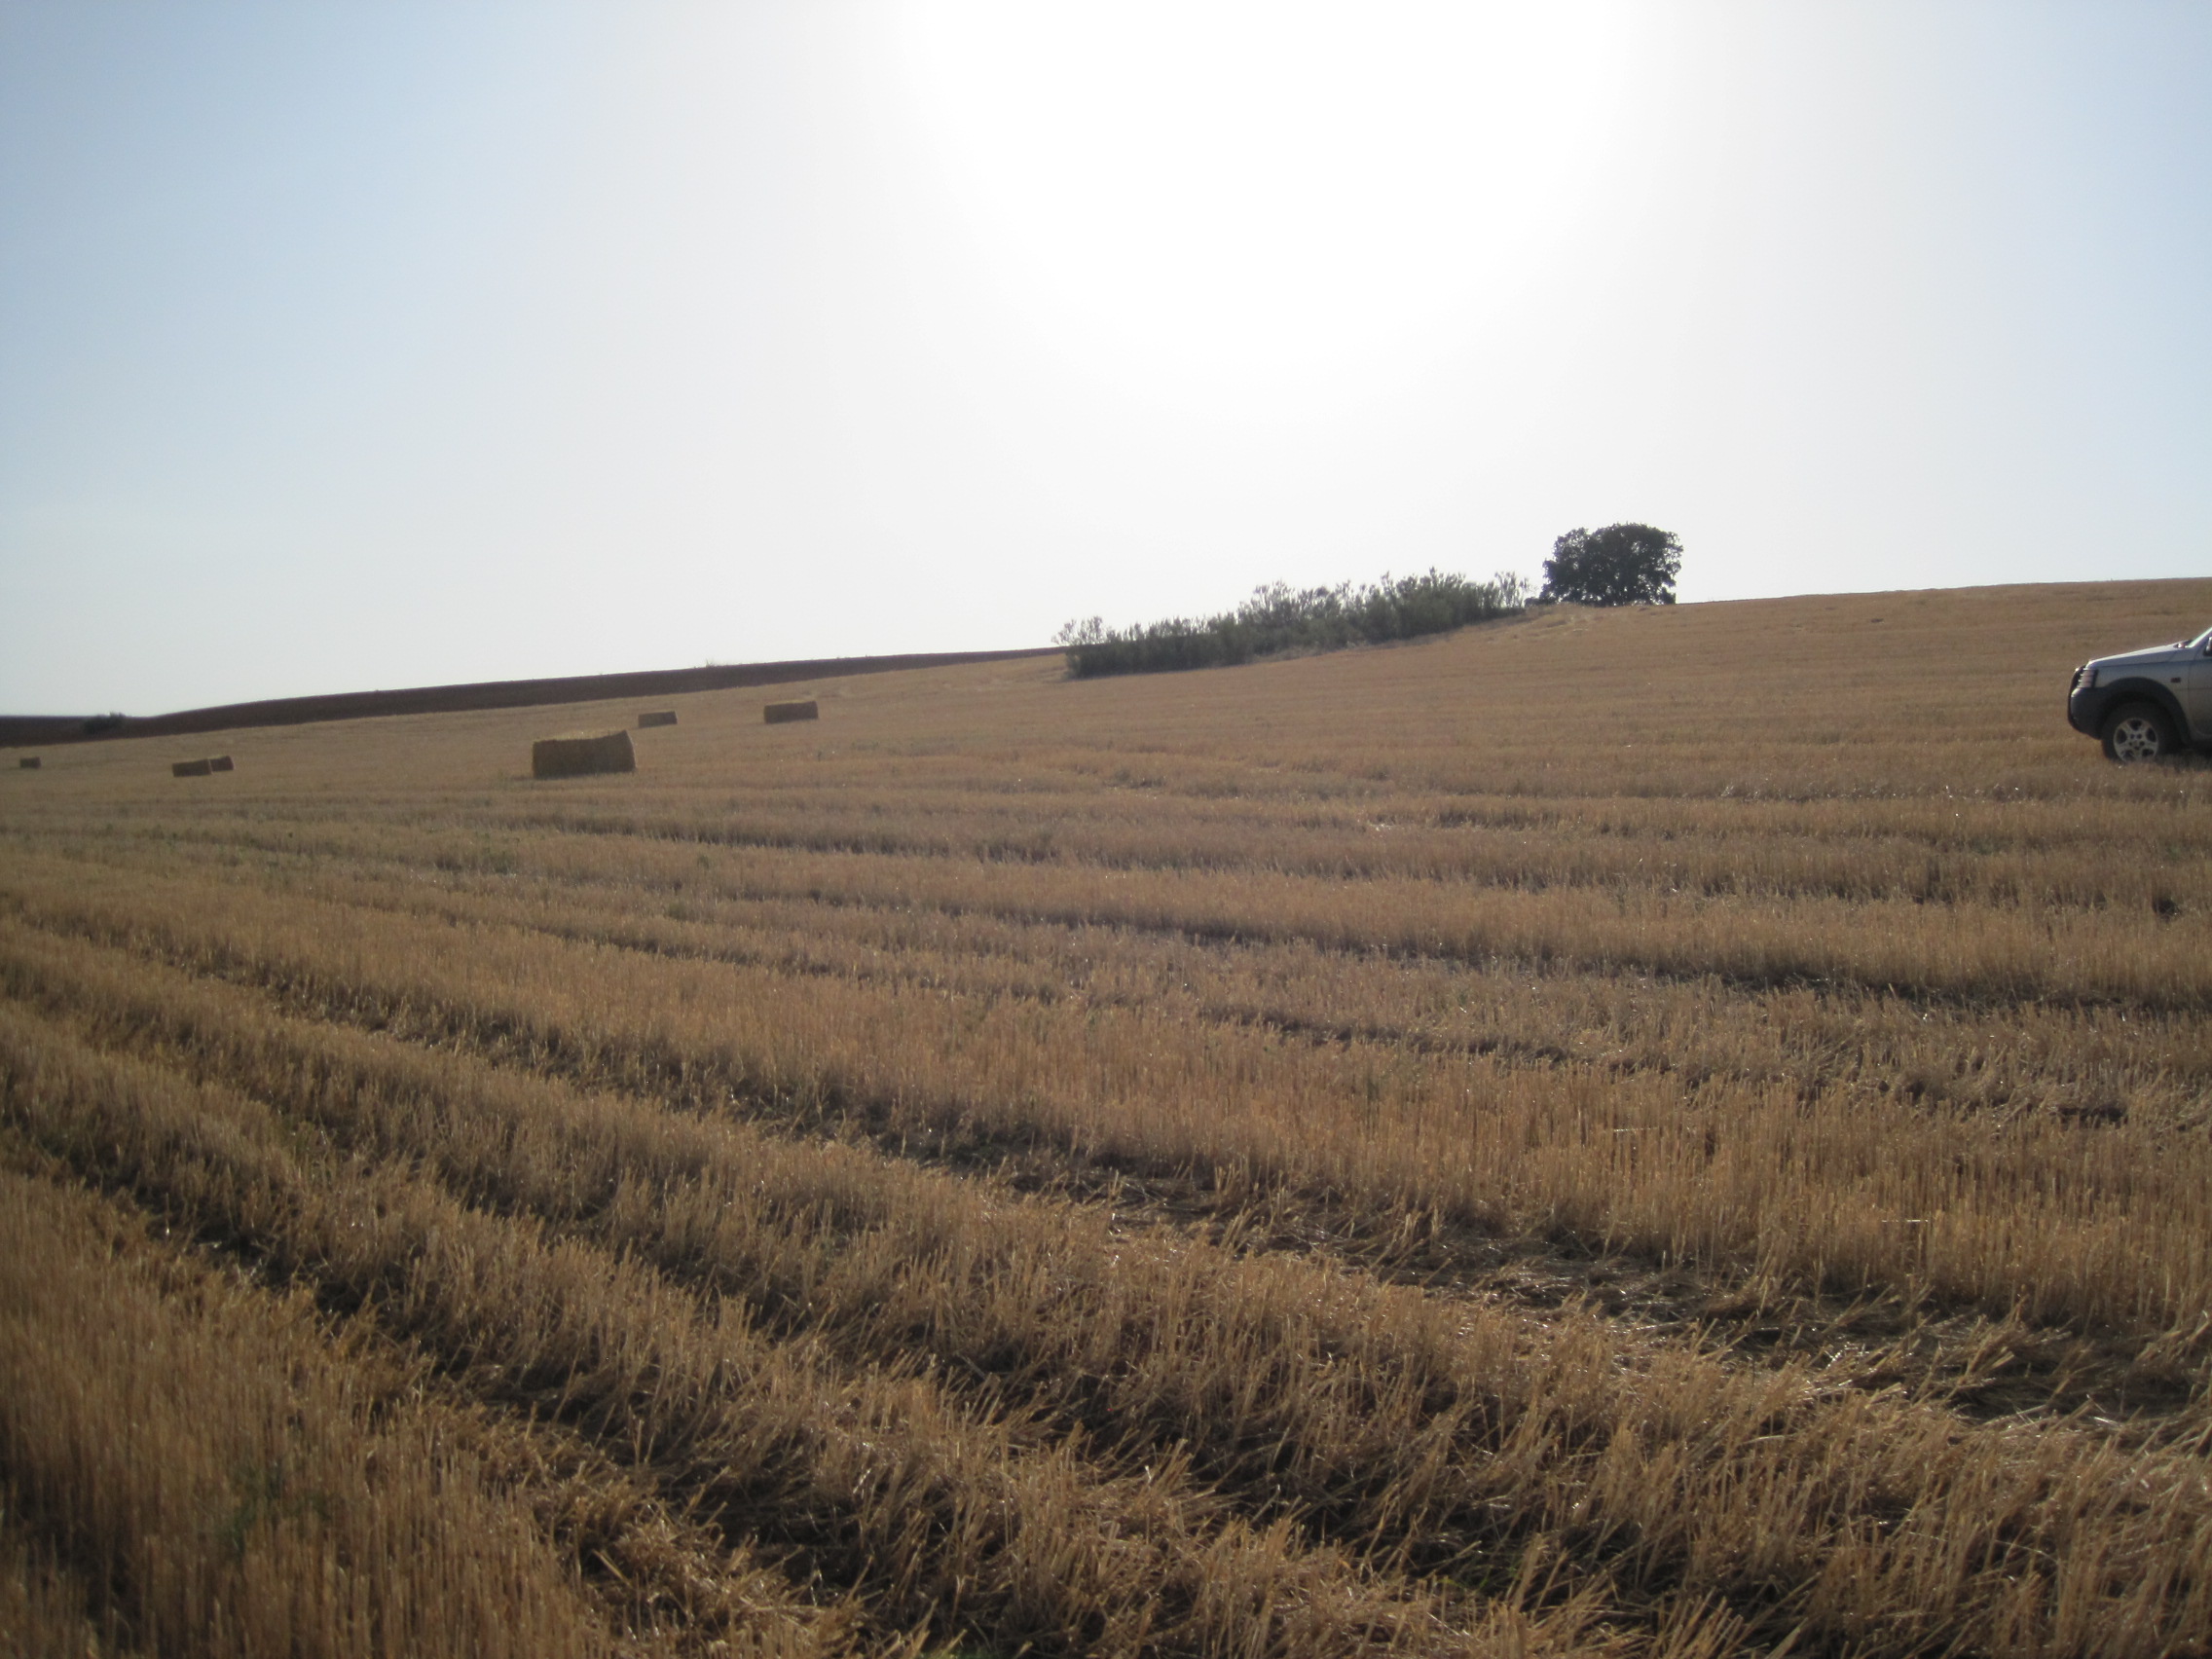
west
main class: Cropland
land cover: Common wheat
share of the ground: < 10 %
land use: Agriculture (excluding fallow land and kitchen gardens)
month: July
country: ES
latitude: 41.7015
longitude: -5.5508
